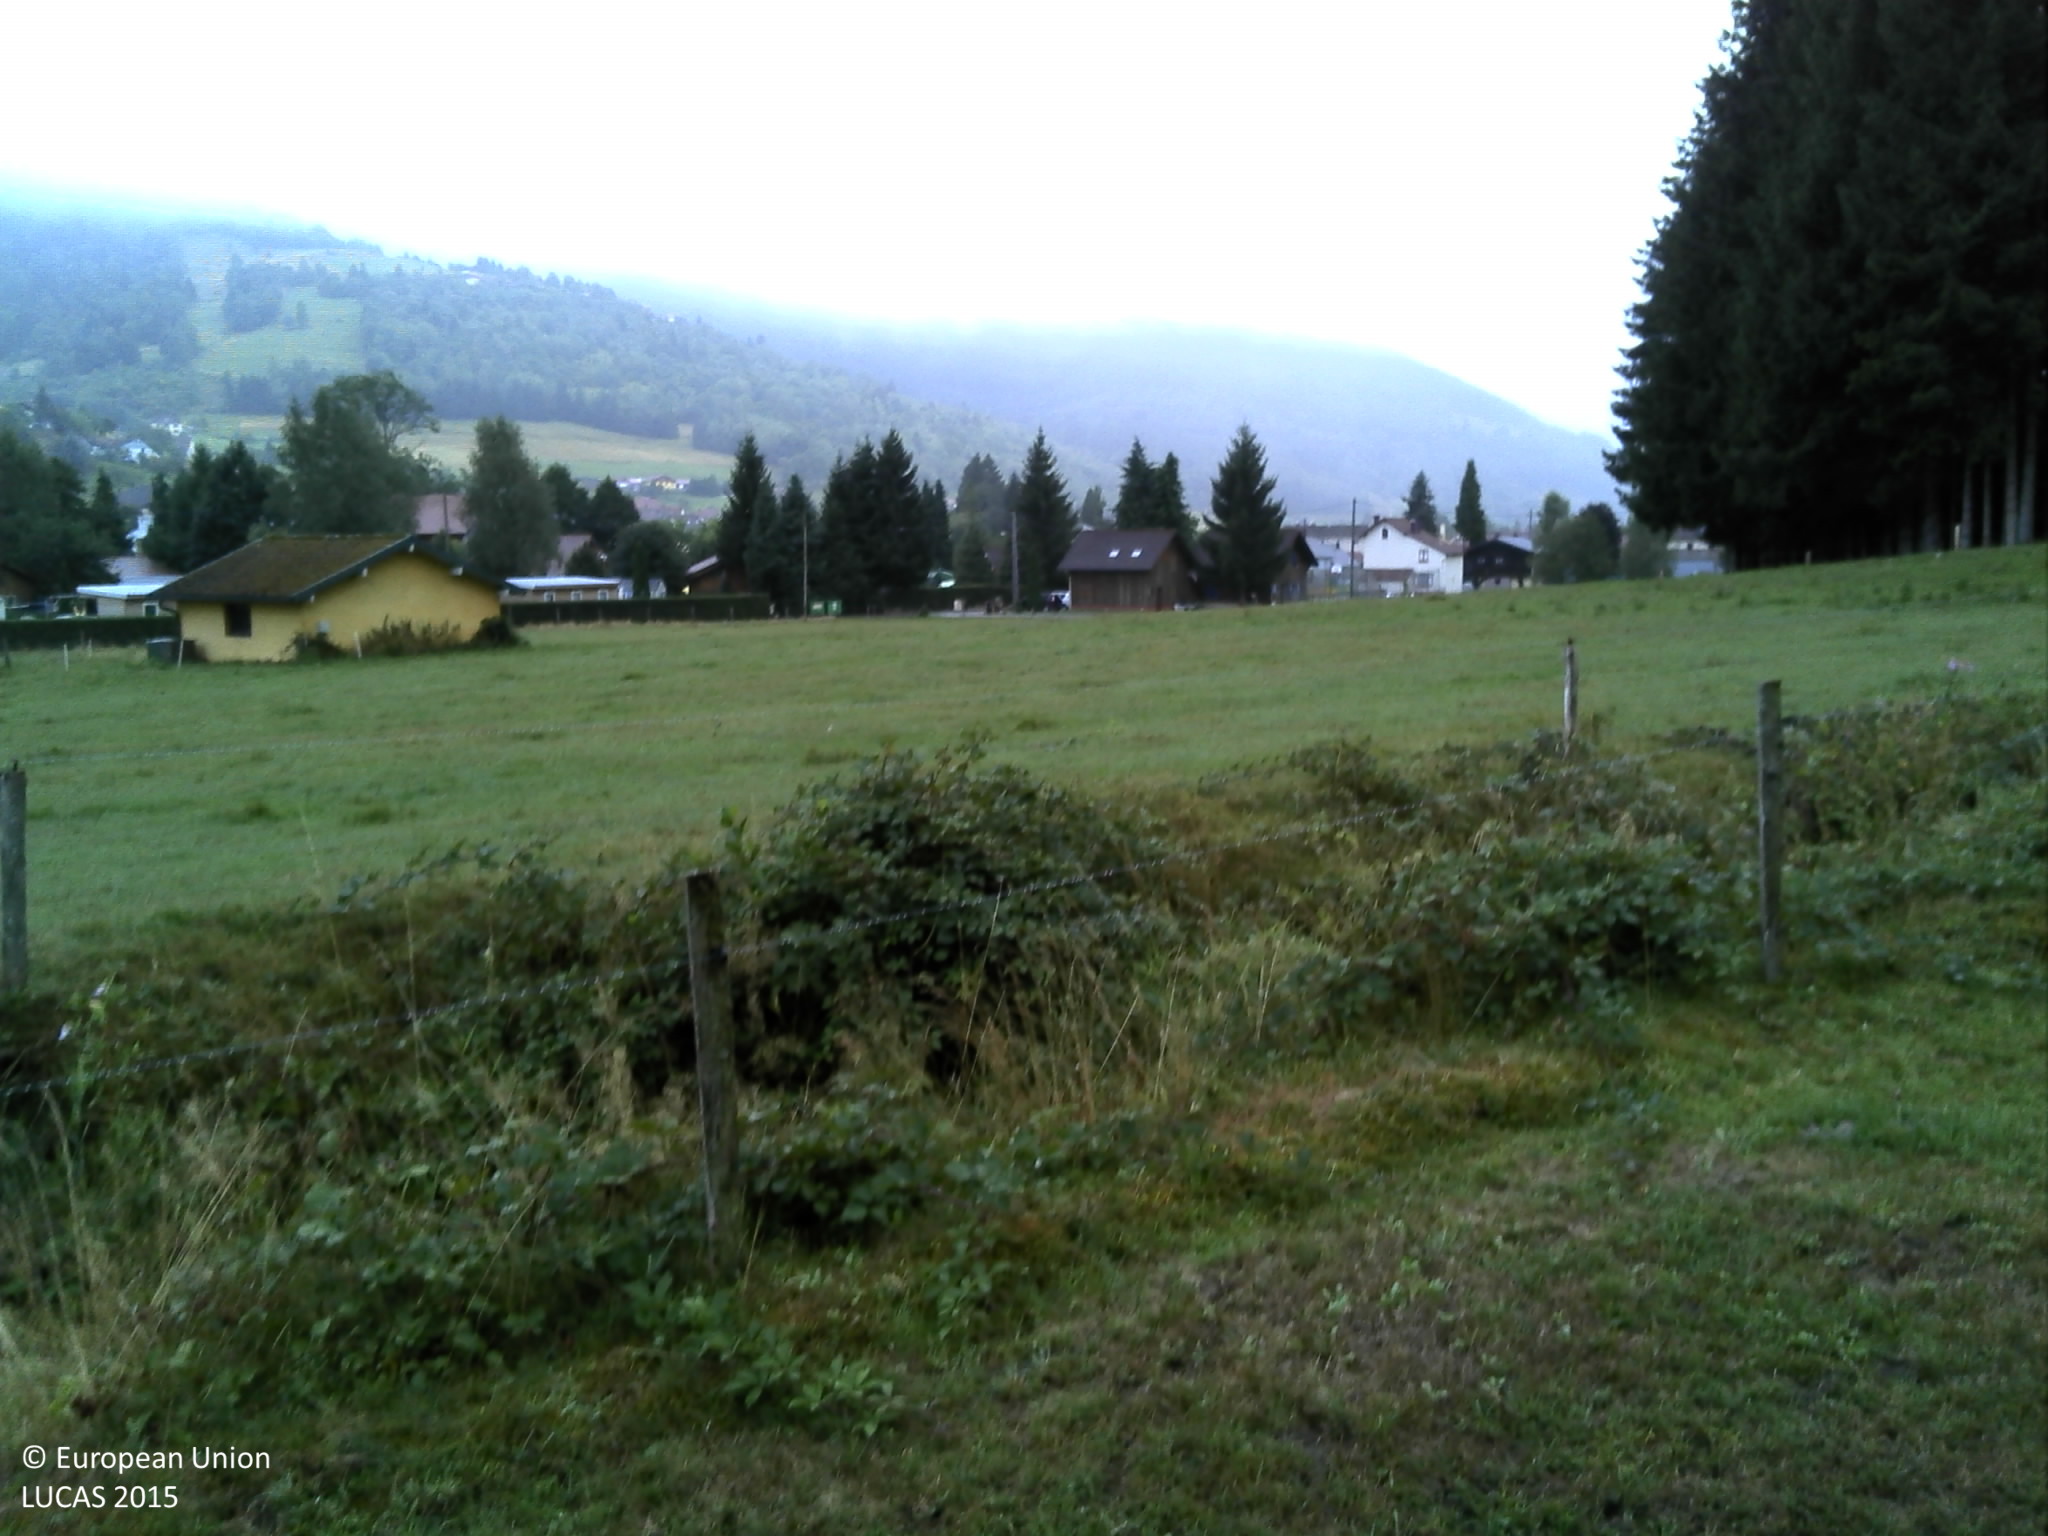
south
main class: Grassland
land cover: Grassland without tree/shrub cover
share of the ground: > 75 %
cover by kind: herbaceous plants 100 %
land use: Agriculture (excluding fallow land and kitchen gardens)
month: August
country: FR
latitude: 47.8907
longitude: 6.8583
